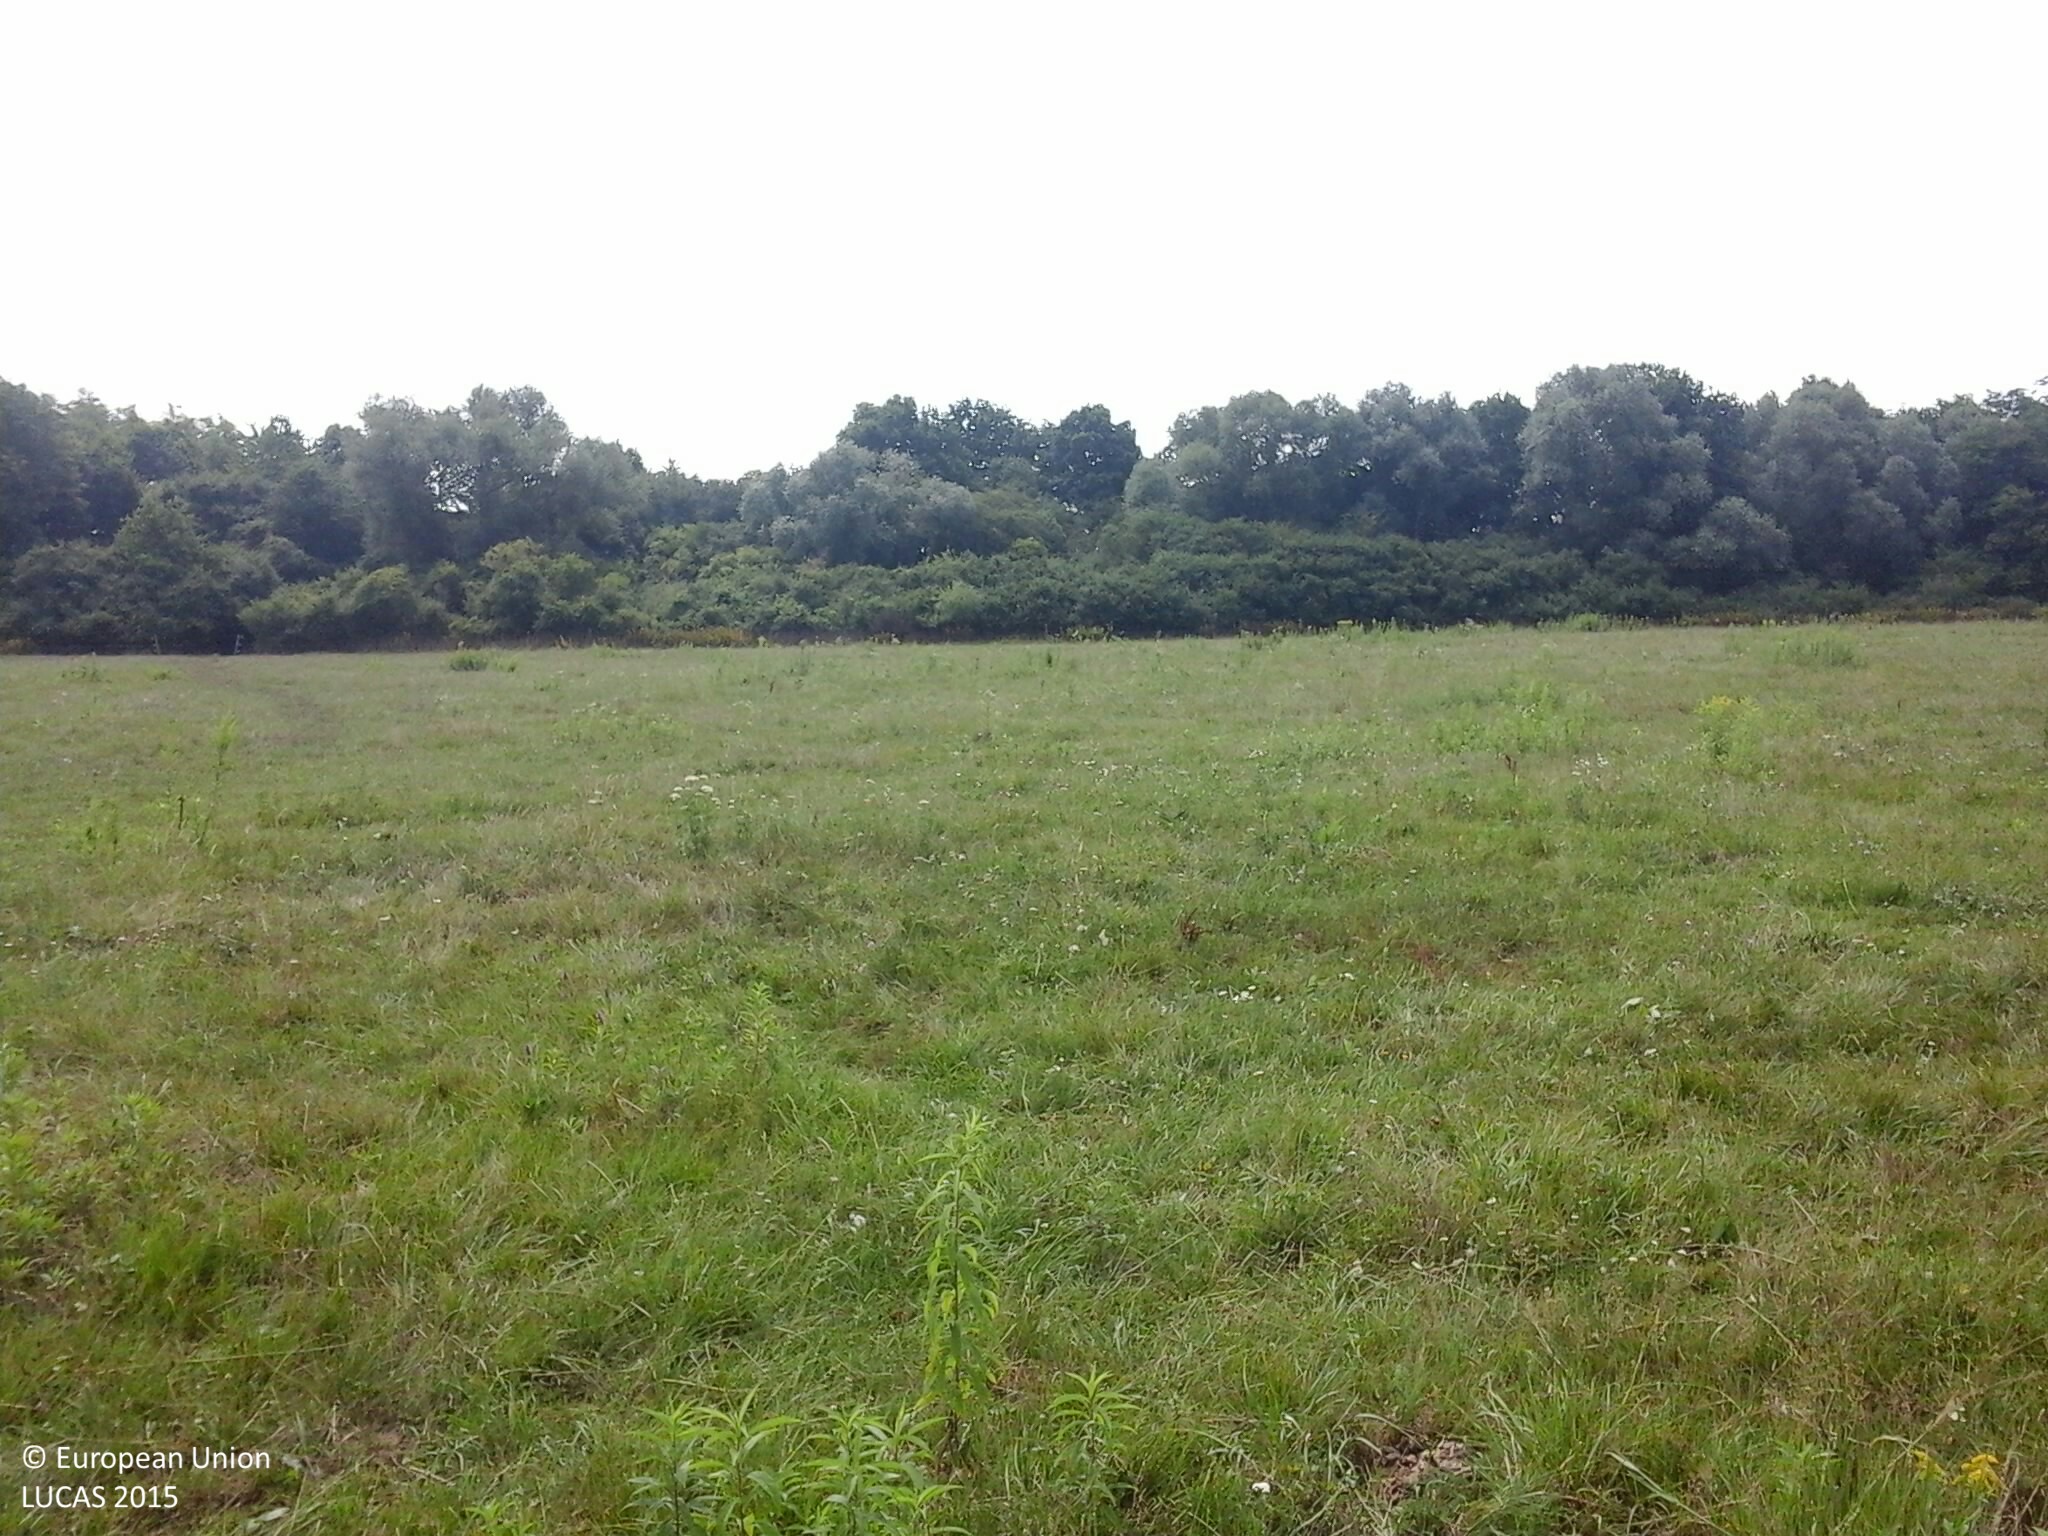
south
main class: Grassland
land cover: Grassland without tree/shrub cover
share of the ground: > 75 %
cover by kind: herbaceous plants 100 %
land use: Agriculture (excluding fallow land and kitchen gardens)
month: July
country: HU
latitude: 47.0407
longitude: 16.4646
